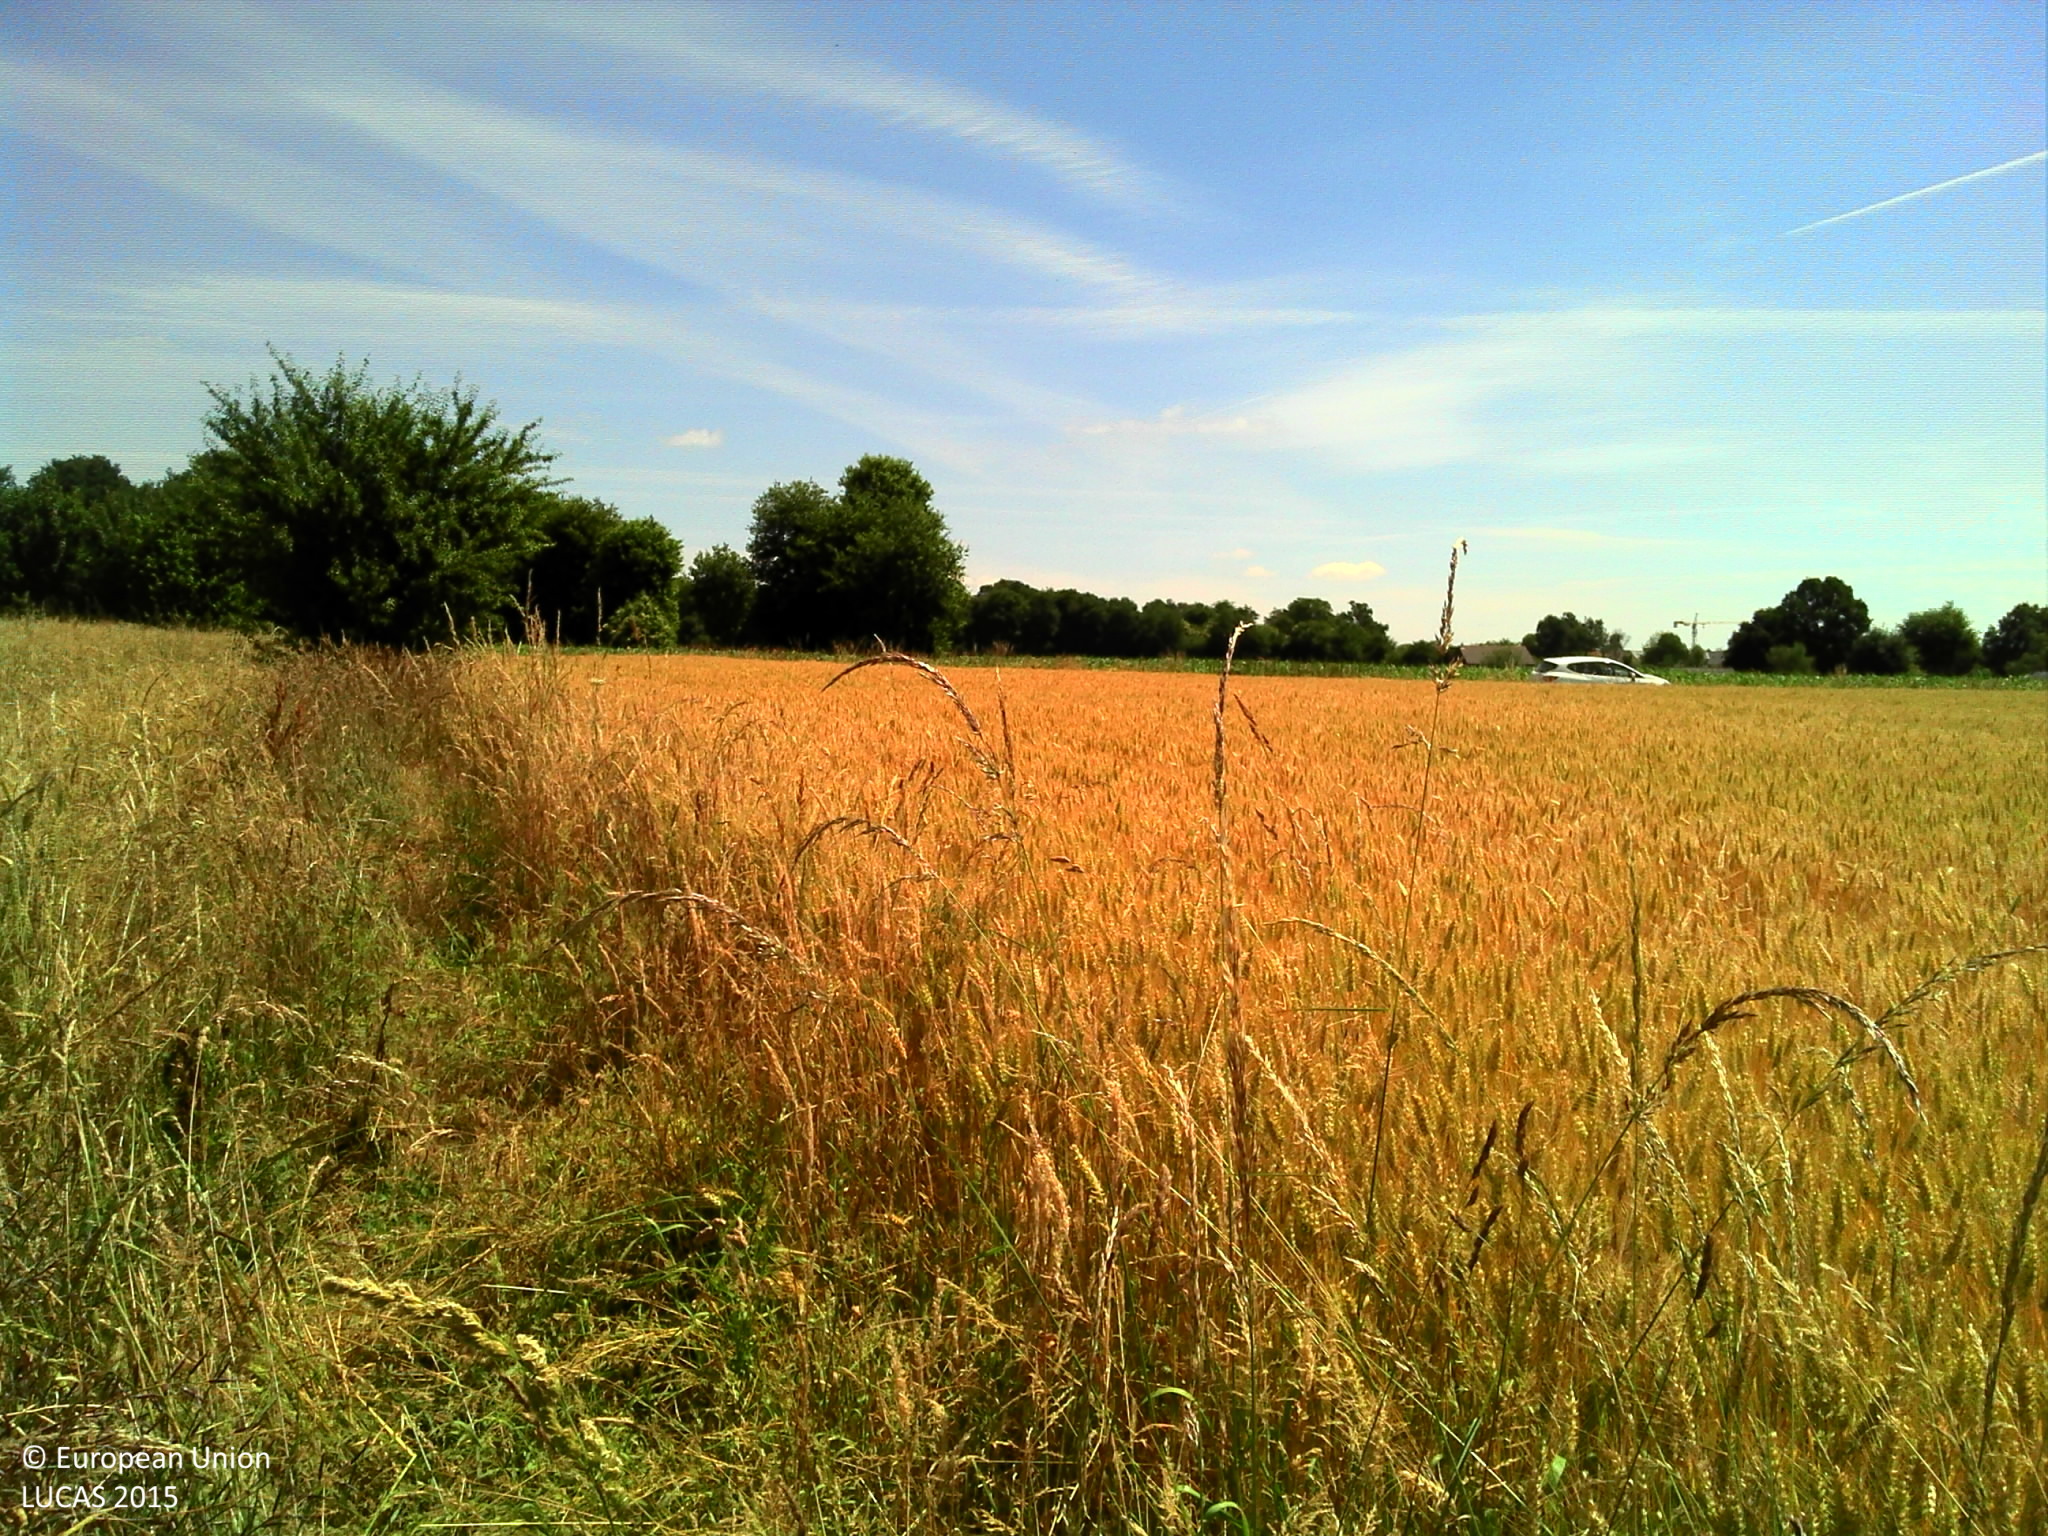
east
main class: Cropland
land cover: Common wheat
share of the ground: > 75 %
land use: Agriculture (excluding fallow land and kitchen gardens)
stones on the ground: < 10 %
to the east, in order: Common wheat; Abandoned hedges; Ditches and canals; Grass margins; Paved roads, cycling and walking lanes; Grass margins; Ditches and canals; Maize; Grass margins; Lines of trees; Grass margins; Maize
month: June
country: FR
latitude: 48.0072
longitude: -1.6147
